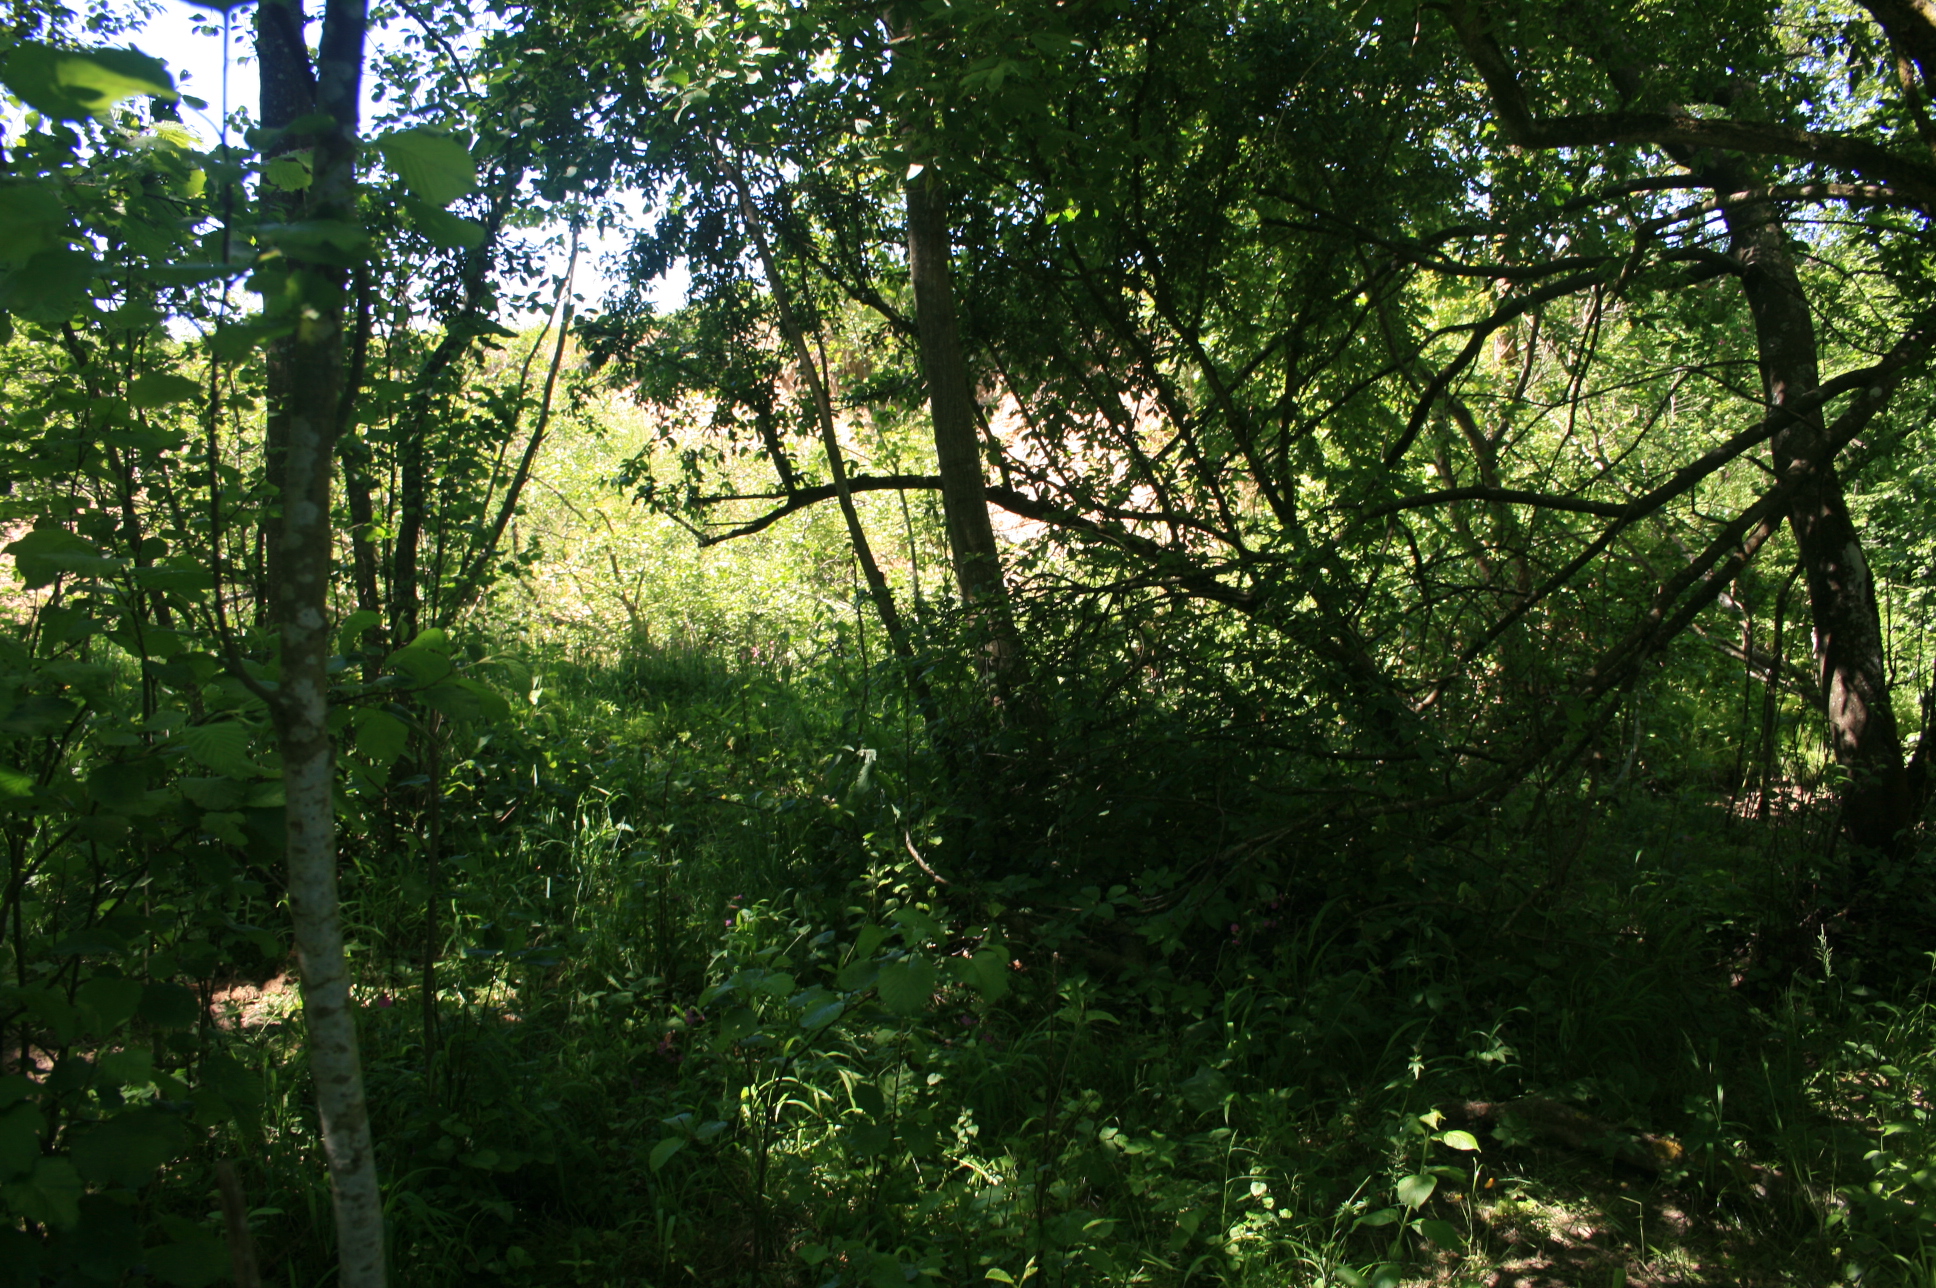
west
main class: Woodland
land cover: Broadleaved woodland
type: floodplain forest
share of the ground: > 75 %
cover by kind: broadleaved forest trees 90 %, herbaceous plants 5 %, unconsolidated bare surface 5 %
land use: Semi-natural and natural areas not in use
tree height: > 5 m
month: June
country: LT
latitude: 55.5532
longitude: 22.1503
